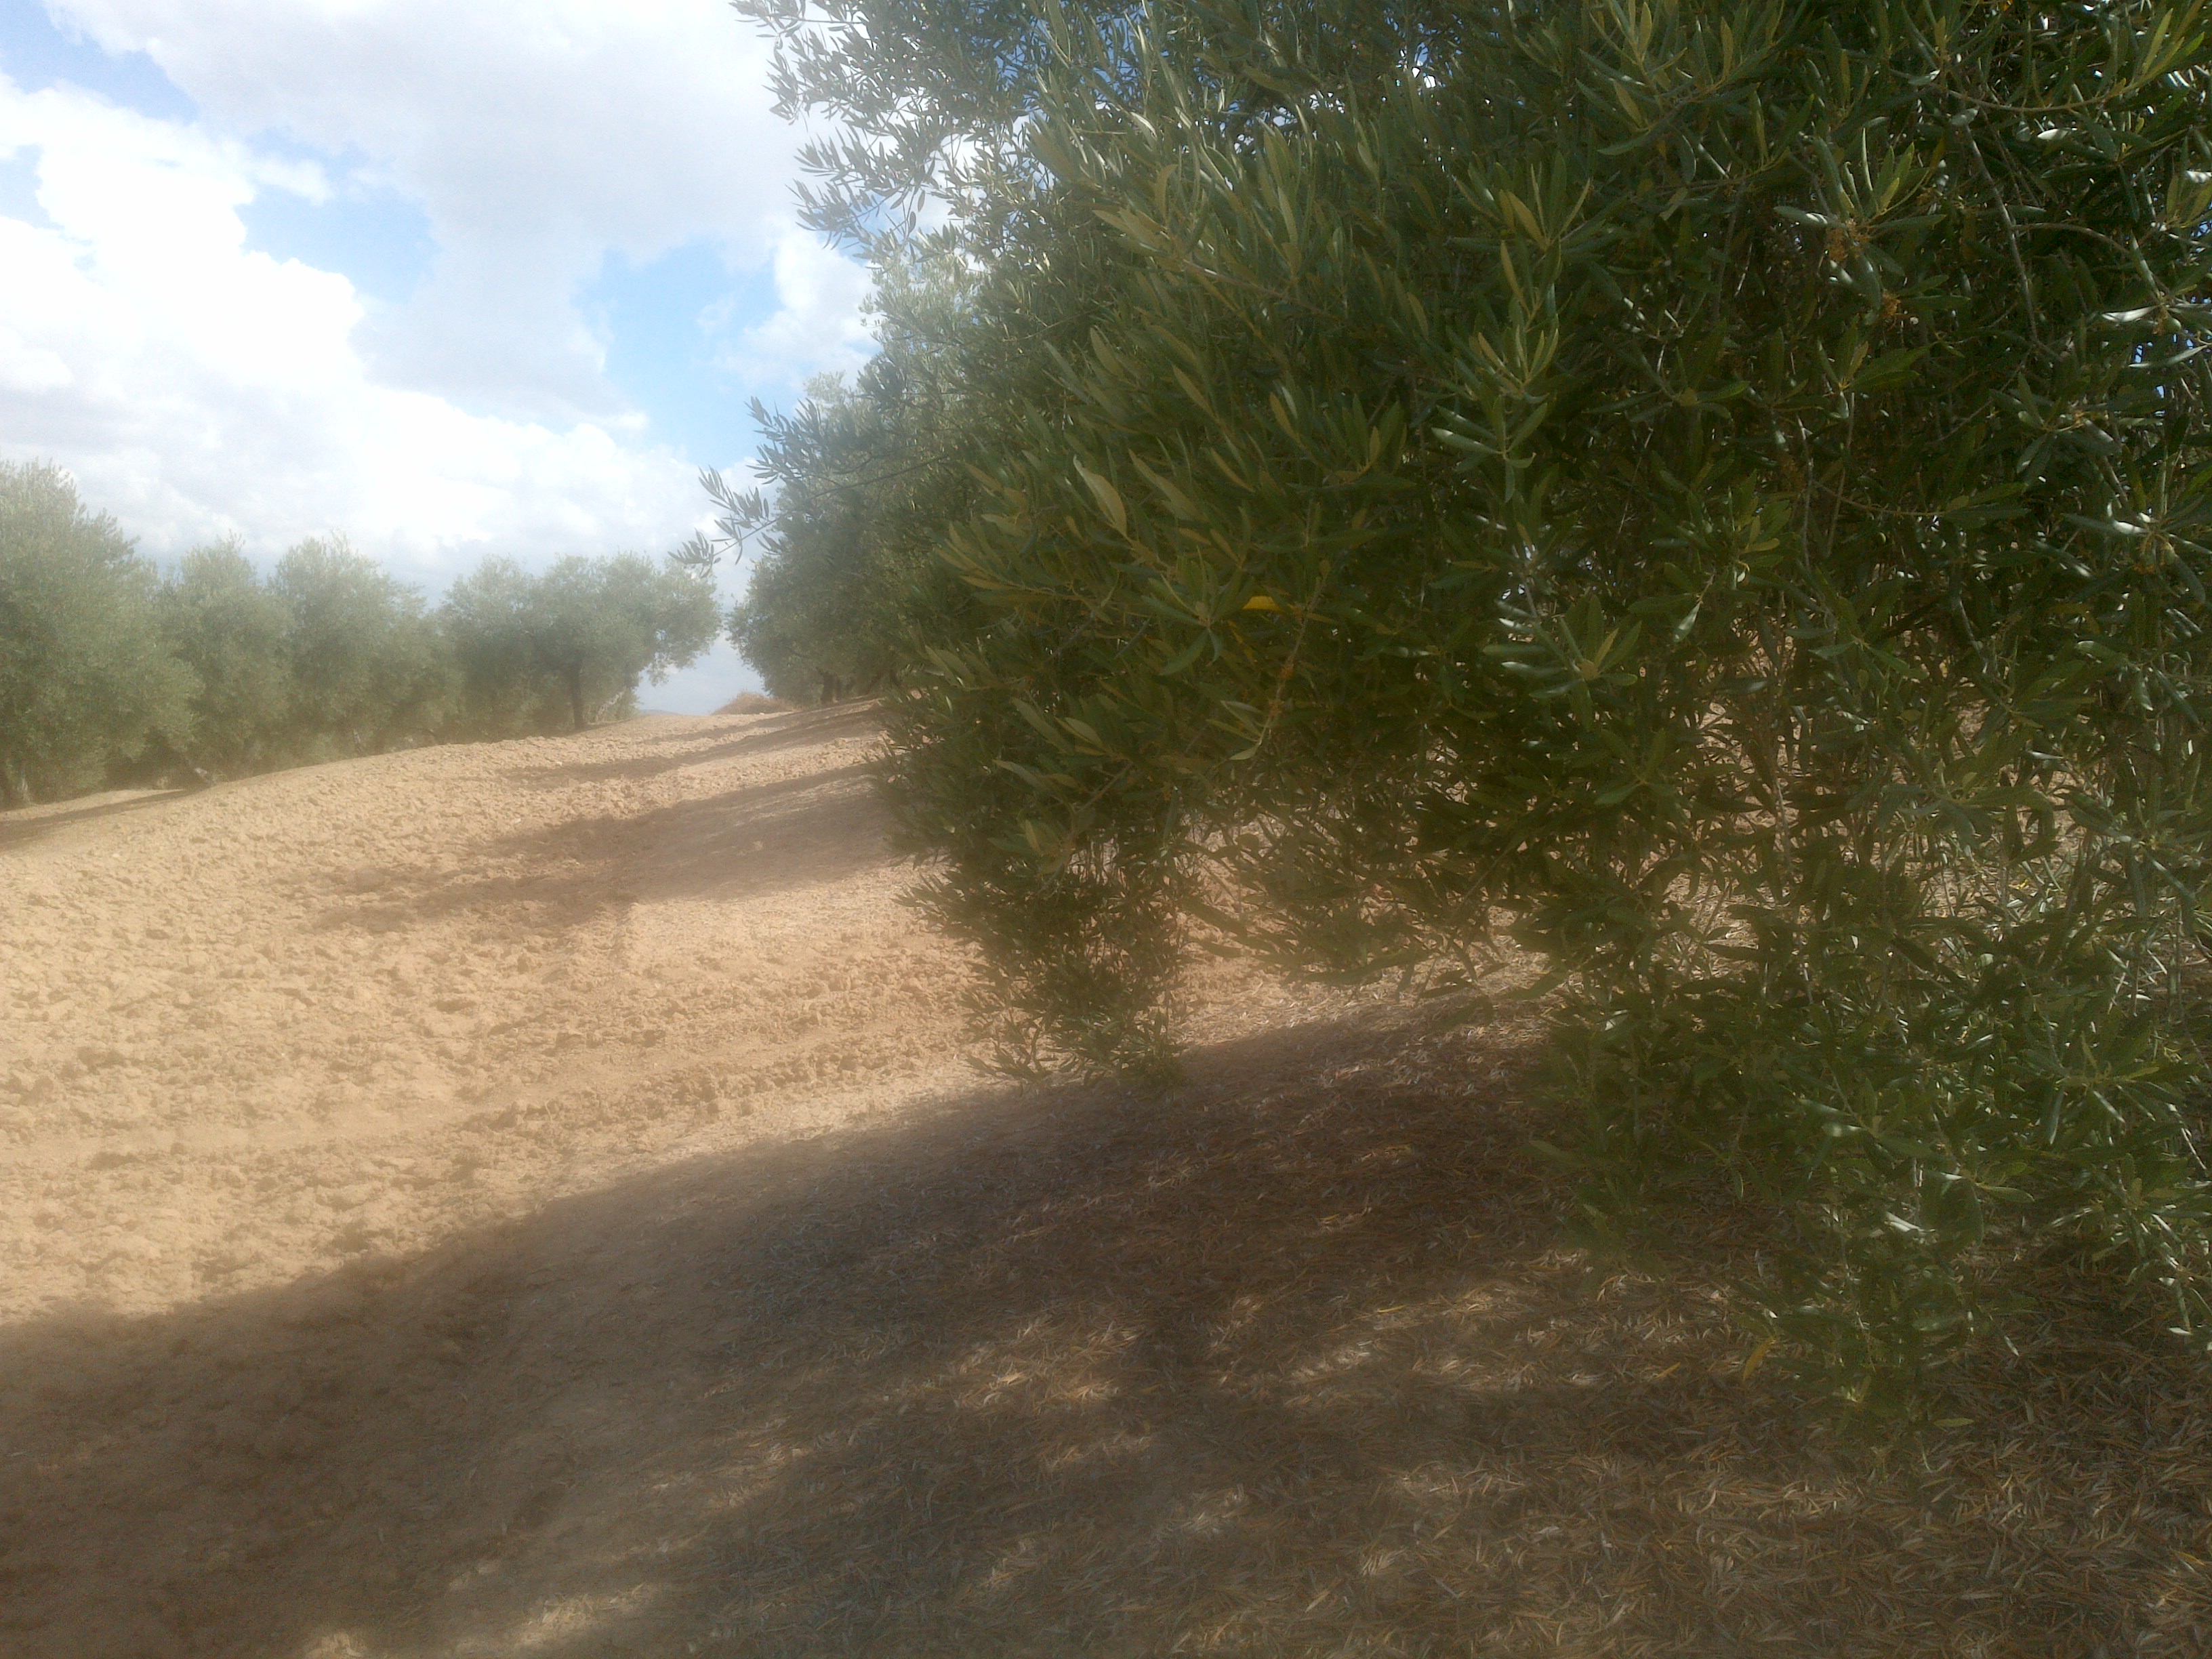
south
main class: Cropland
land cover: Olive groves
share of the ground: 50 - 75 %
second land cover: Other bare soil
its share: > 75 %
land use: Agriculture (excluding fallow land and kitchen gardens)
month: June
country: ES
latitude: 37.7706
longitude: -4.2534
